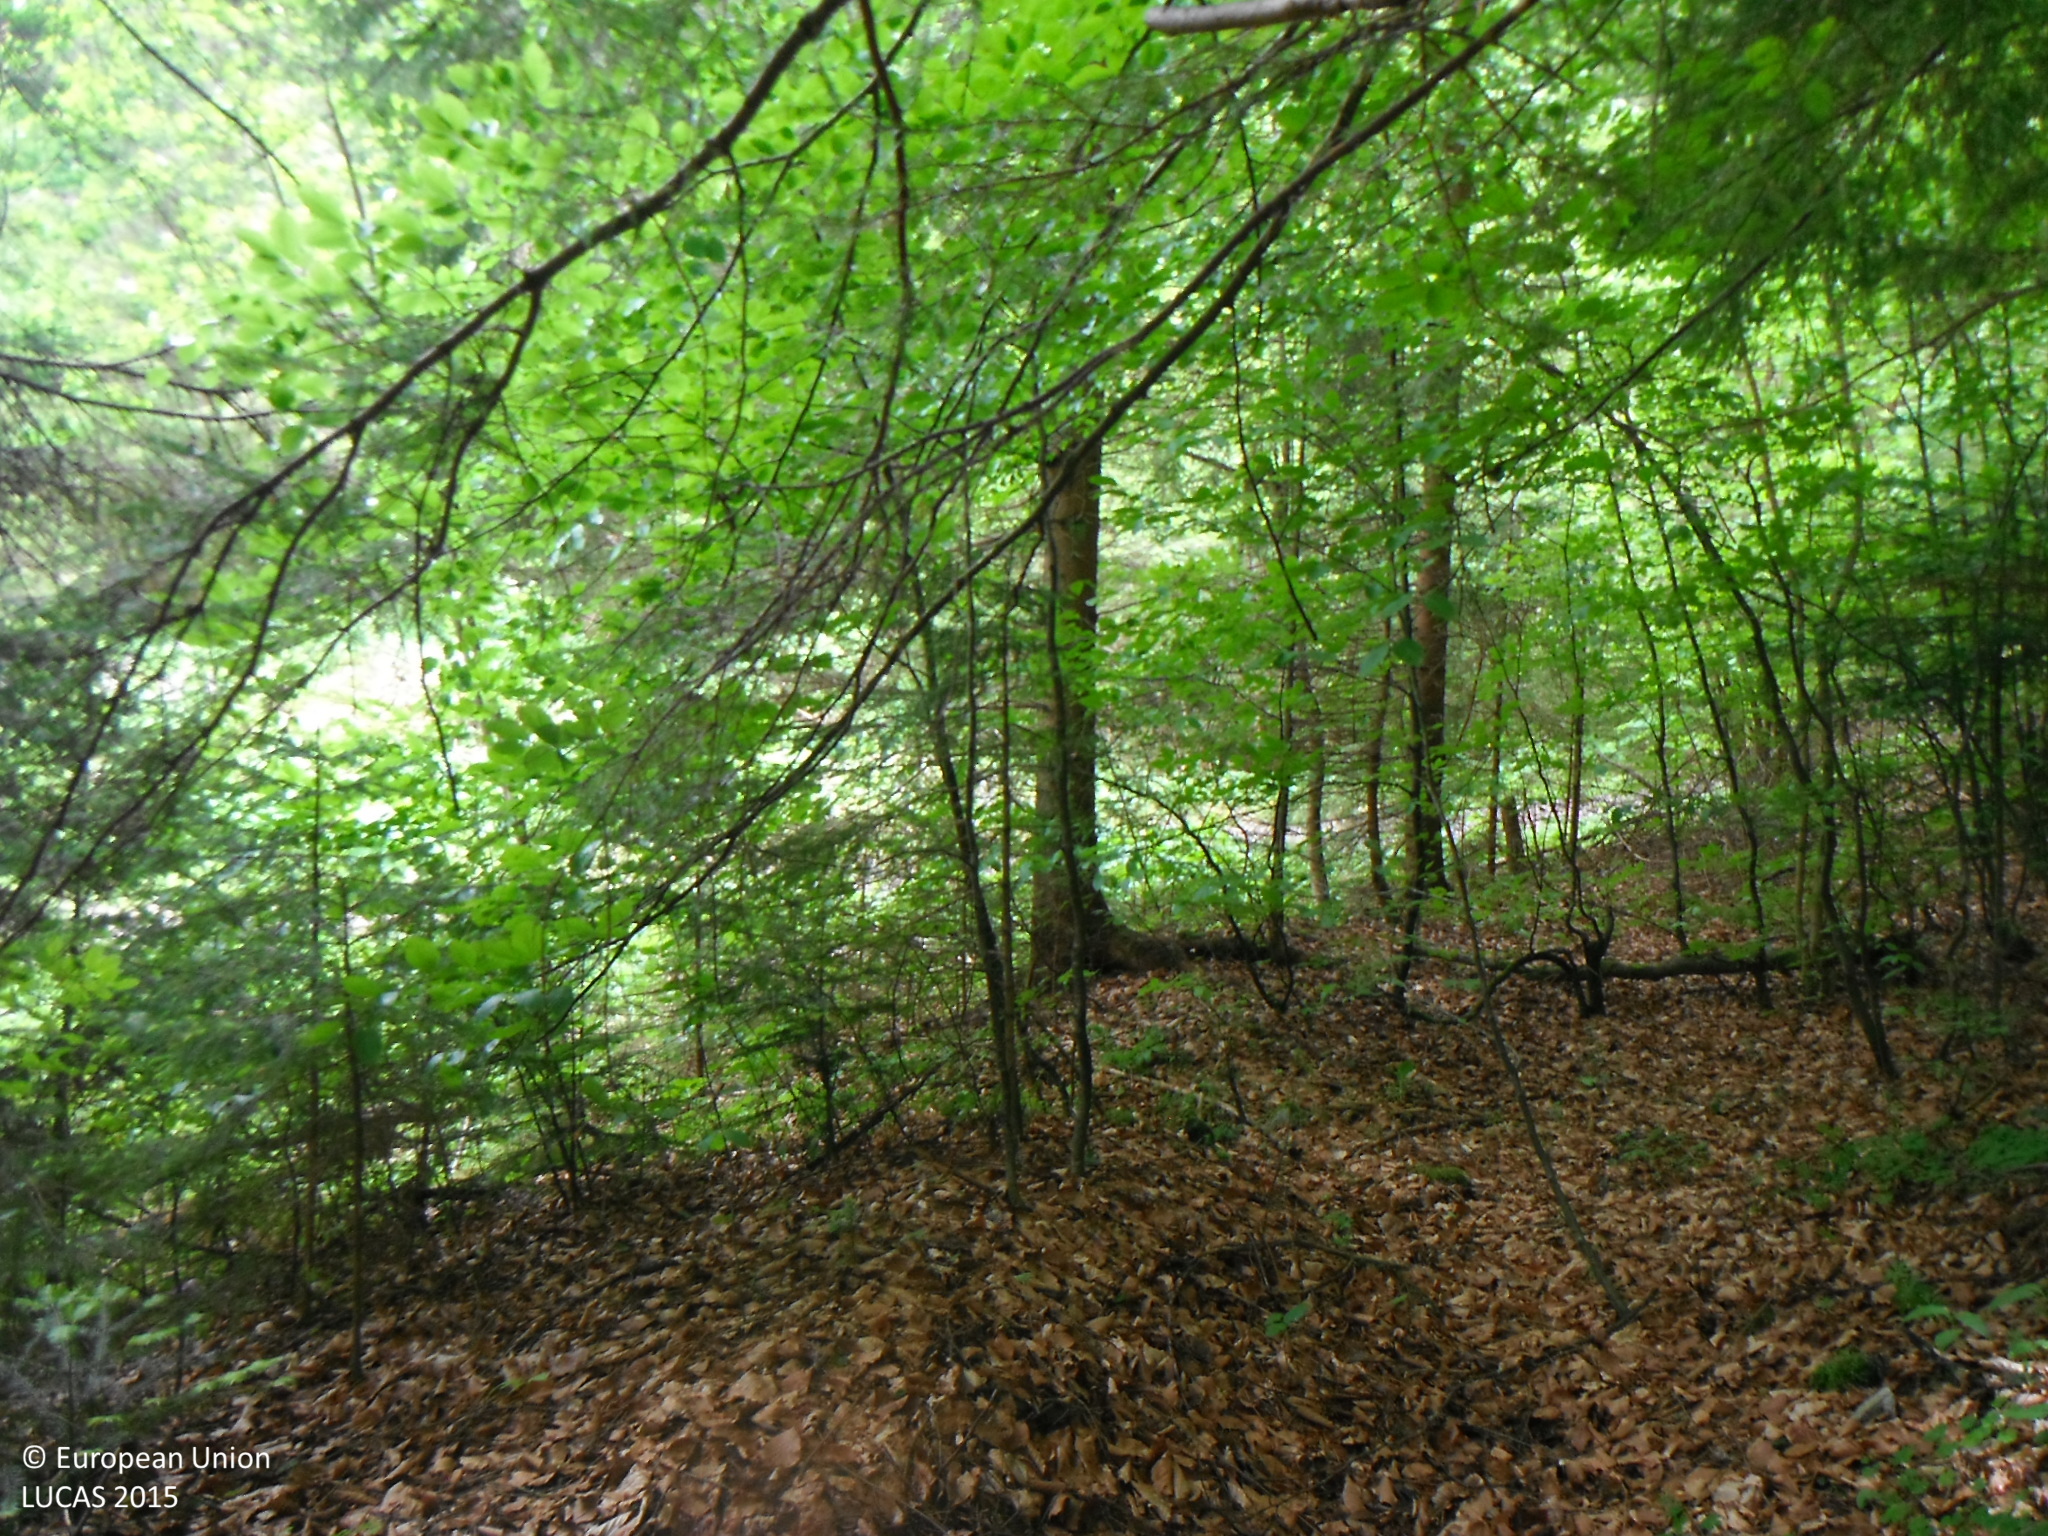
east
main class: Woodland
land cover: Spruce dominated mixed woodland
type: hemiboreal forest and nemoral coniferous forest and mixed broadleaved-coniferous forest
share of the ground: > 75 %
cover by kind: coniferous forest trees 70 %, broadleaved forest trees 30 %
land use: Forestry
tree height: > 5 m
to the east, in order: Spruce dominated mixed woodland
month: May
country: SK
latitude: 49.0086
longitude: 19.0588
